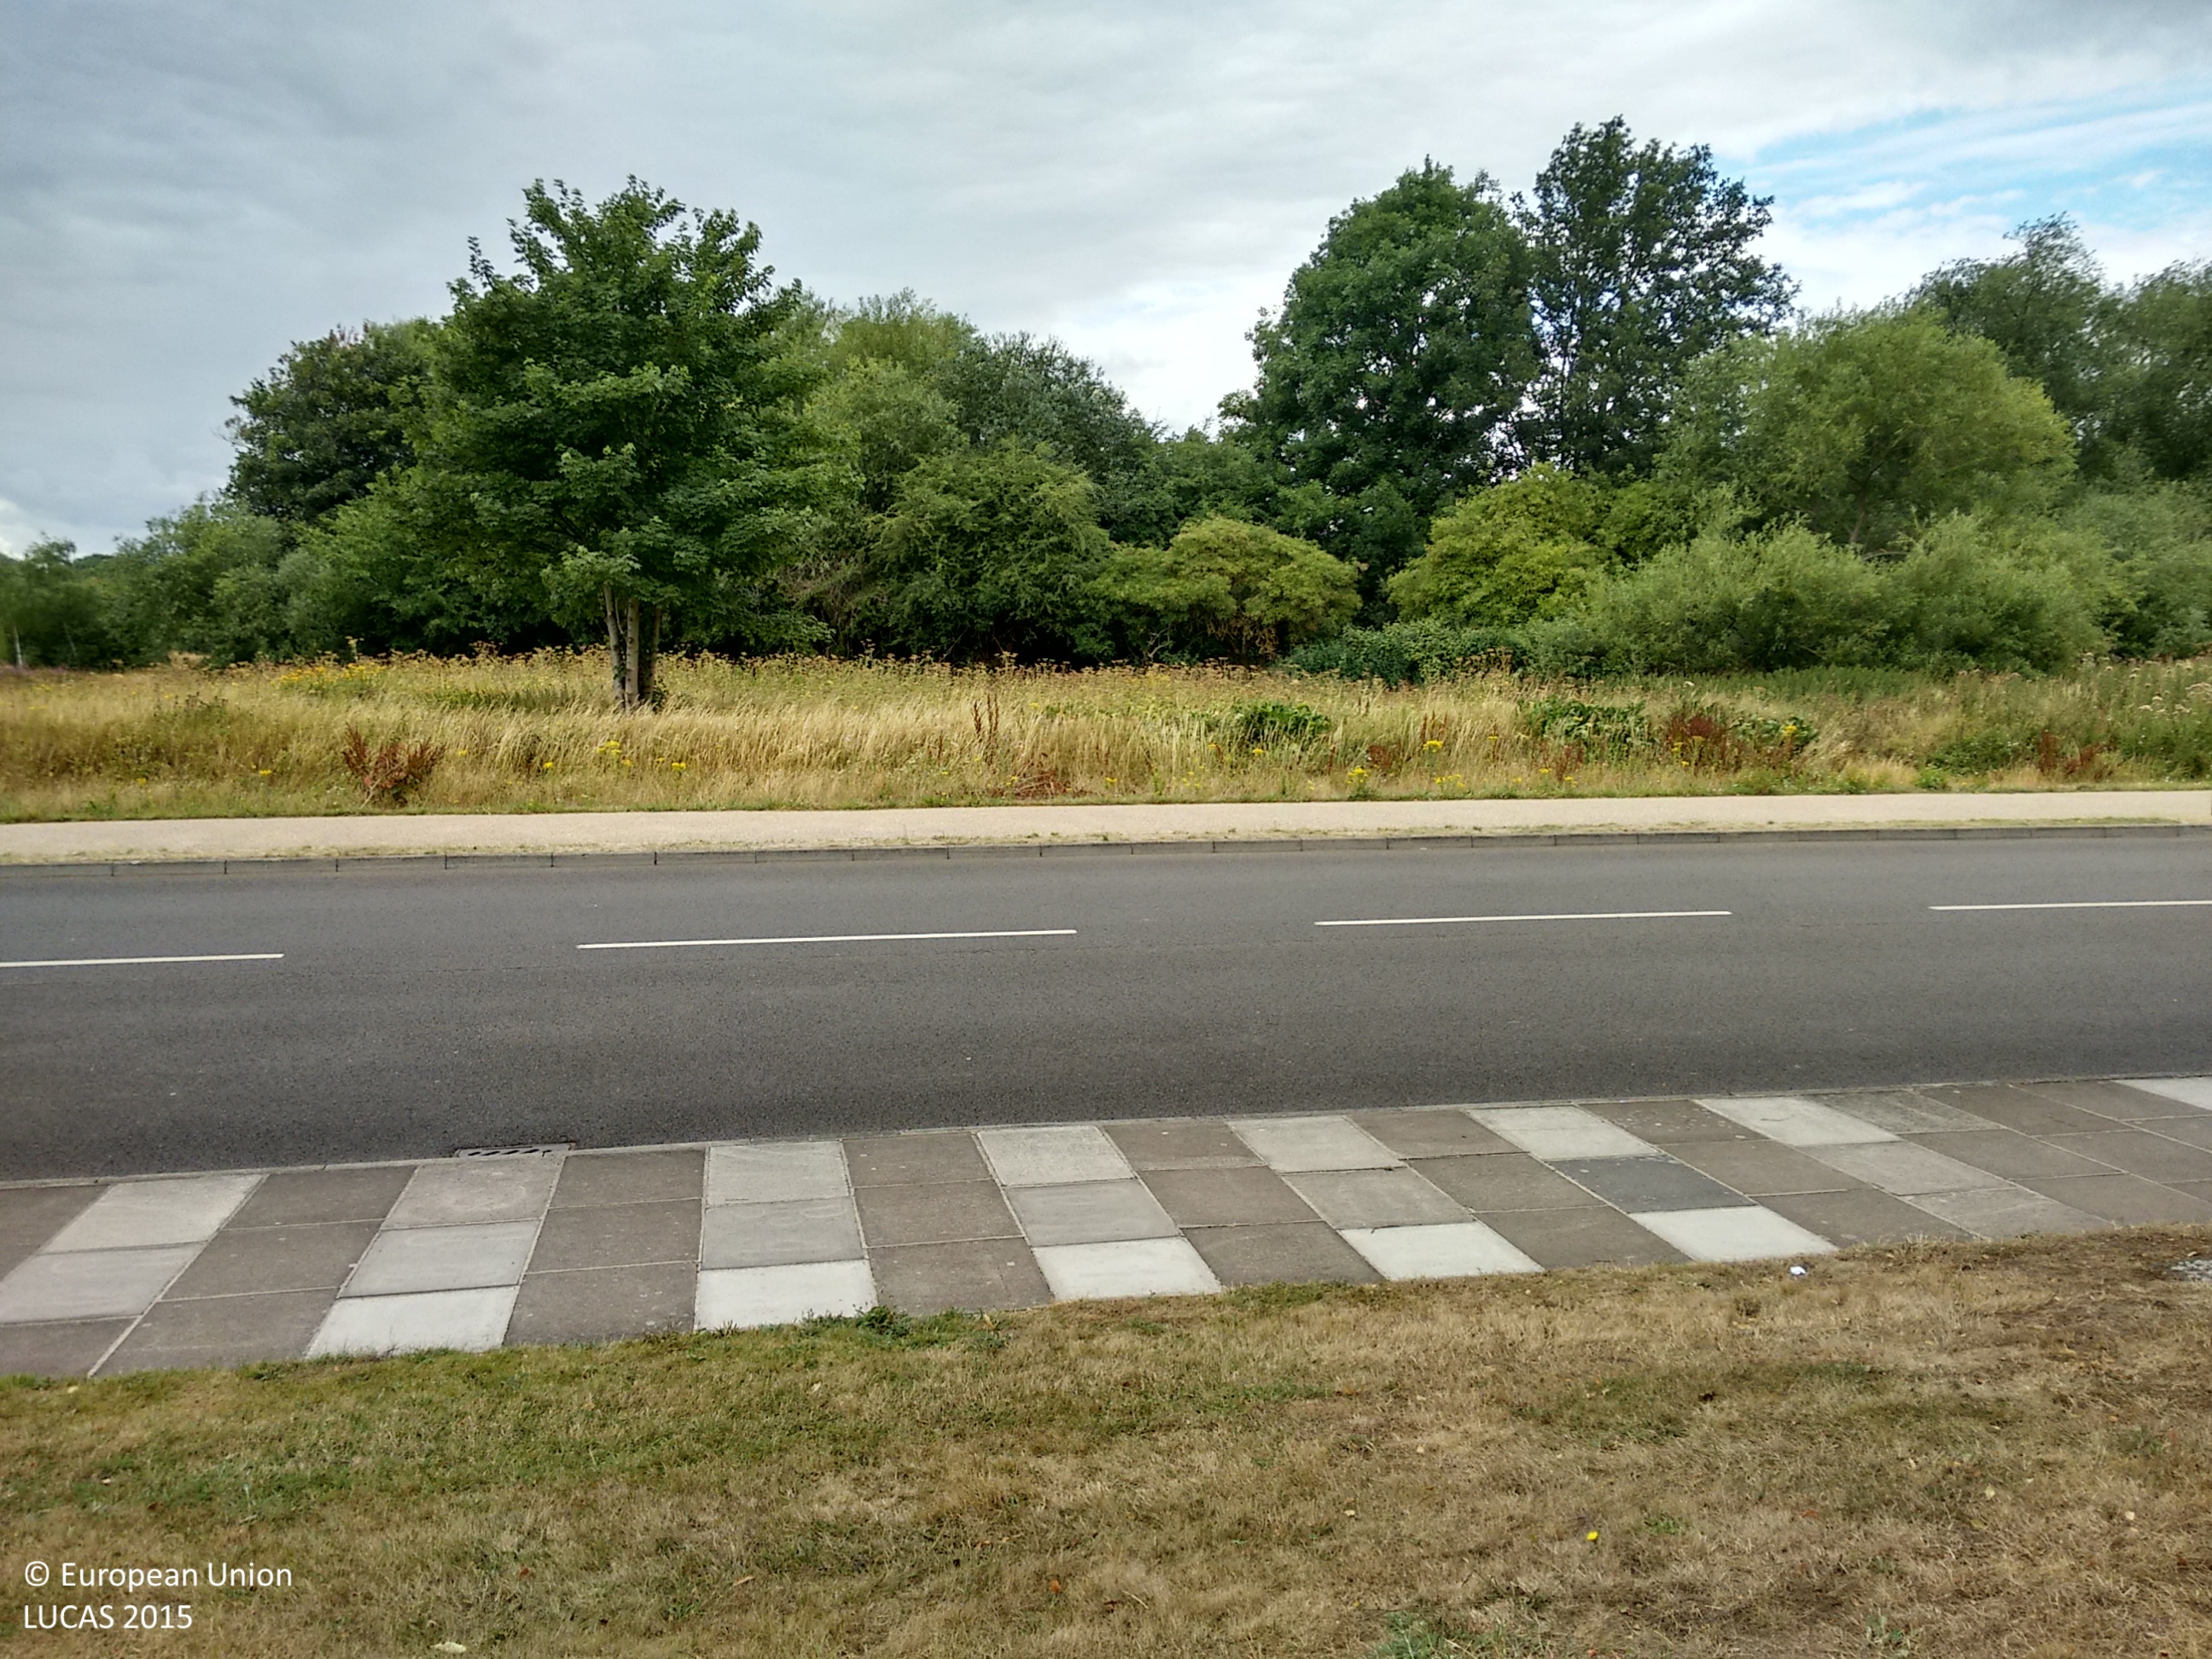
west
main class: Woodland
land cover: Broadleaved woodland
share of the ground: > 75 %
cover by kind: broadleaved forest trees 50 %, herbaceous plants 50 %
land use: Residential
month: July
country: GB
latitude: 51.4368
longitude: -0.3220
